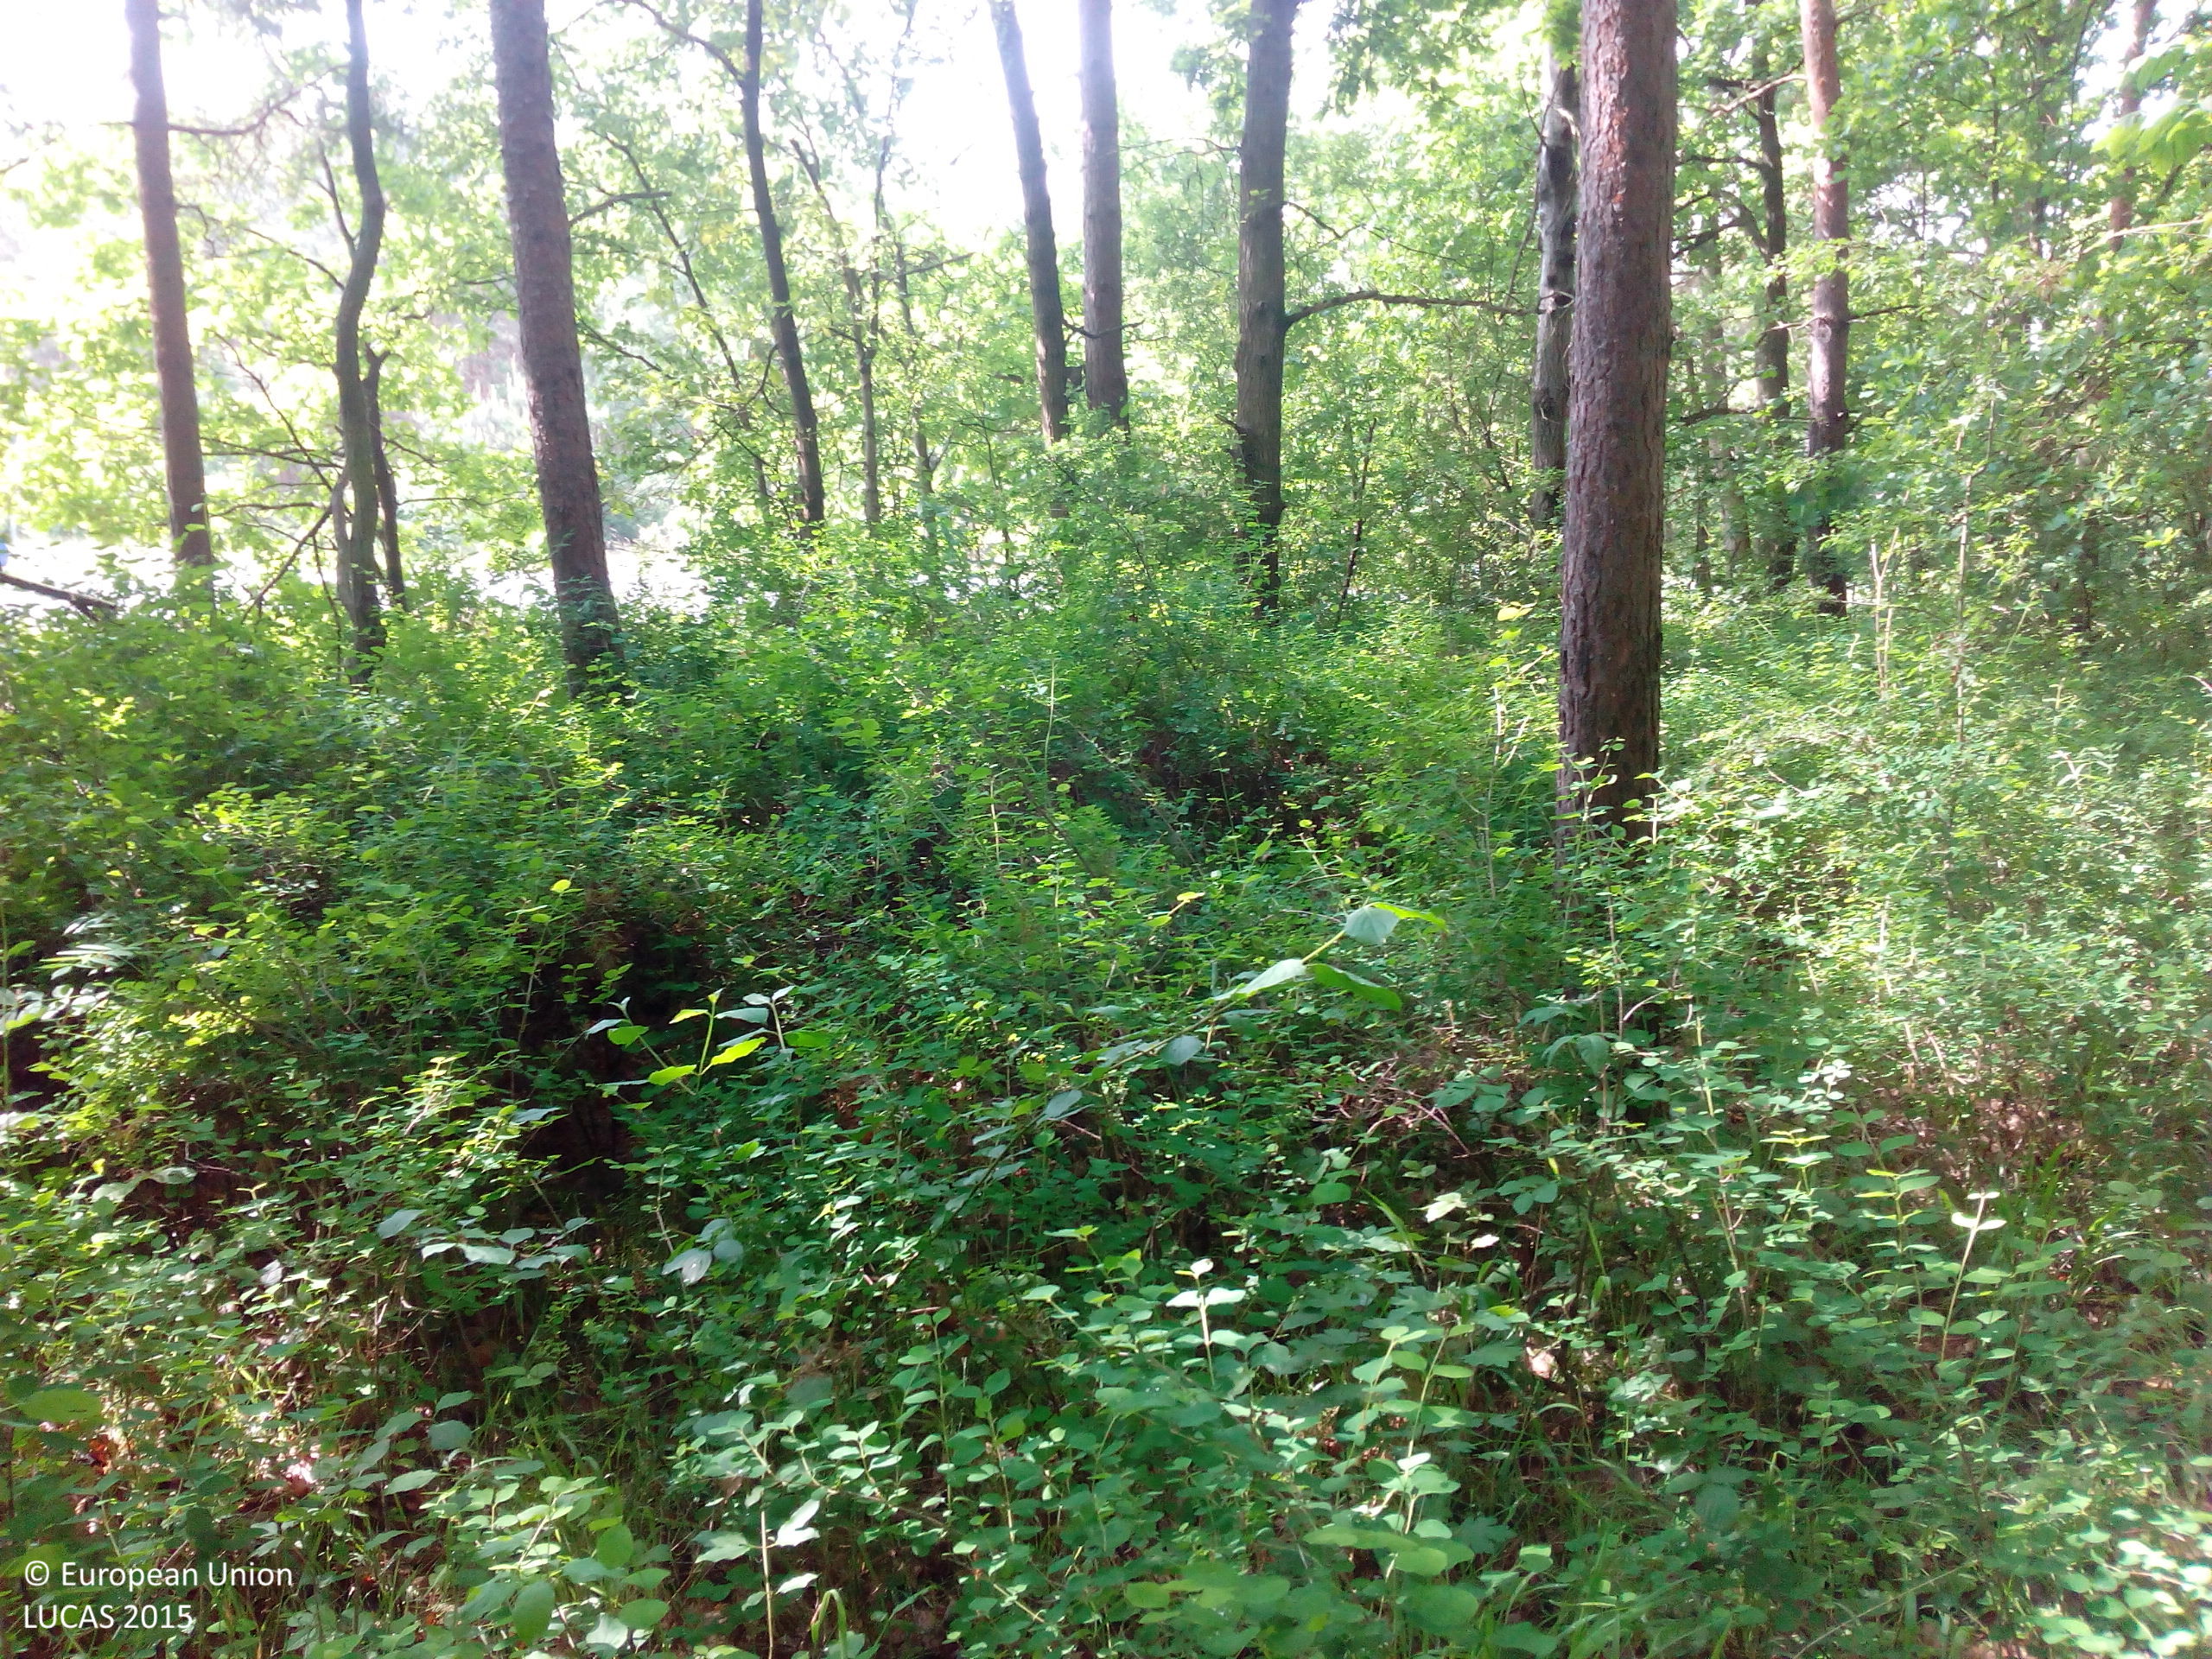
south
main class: Woodland
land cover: Pine dominated mixed woodland
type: hemiboreal forest and nemoral coniferous forest and mixed broadleaved-coniferous forest
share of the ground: > 75 %
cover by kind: coniferous forest trees 55 %, broadleaved forest trees 40 %, shrubs 5 %
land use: Forestry
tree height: > 5 m
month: May
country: DE
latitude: 51.6882
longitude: 12.3865
